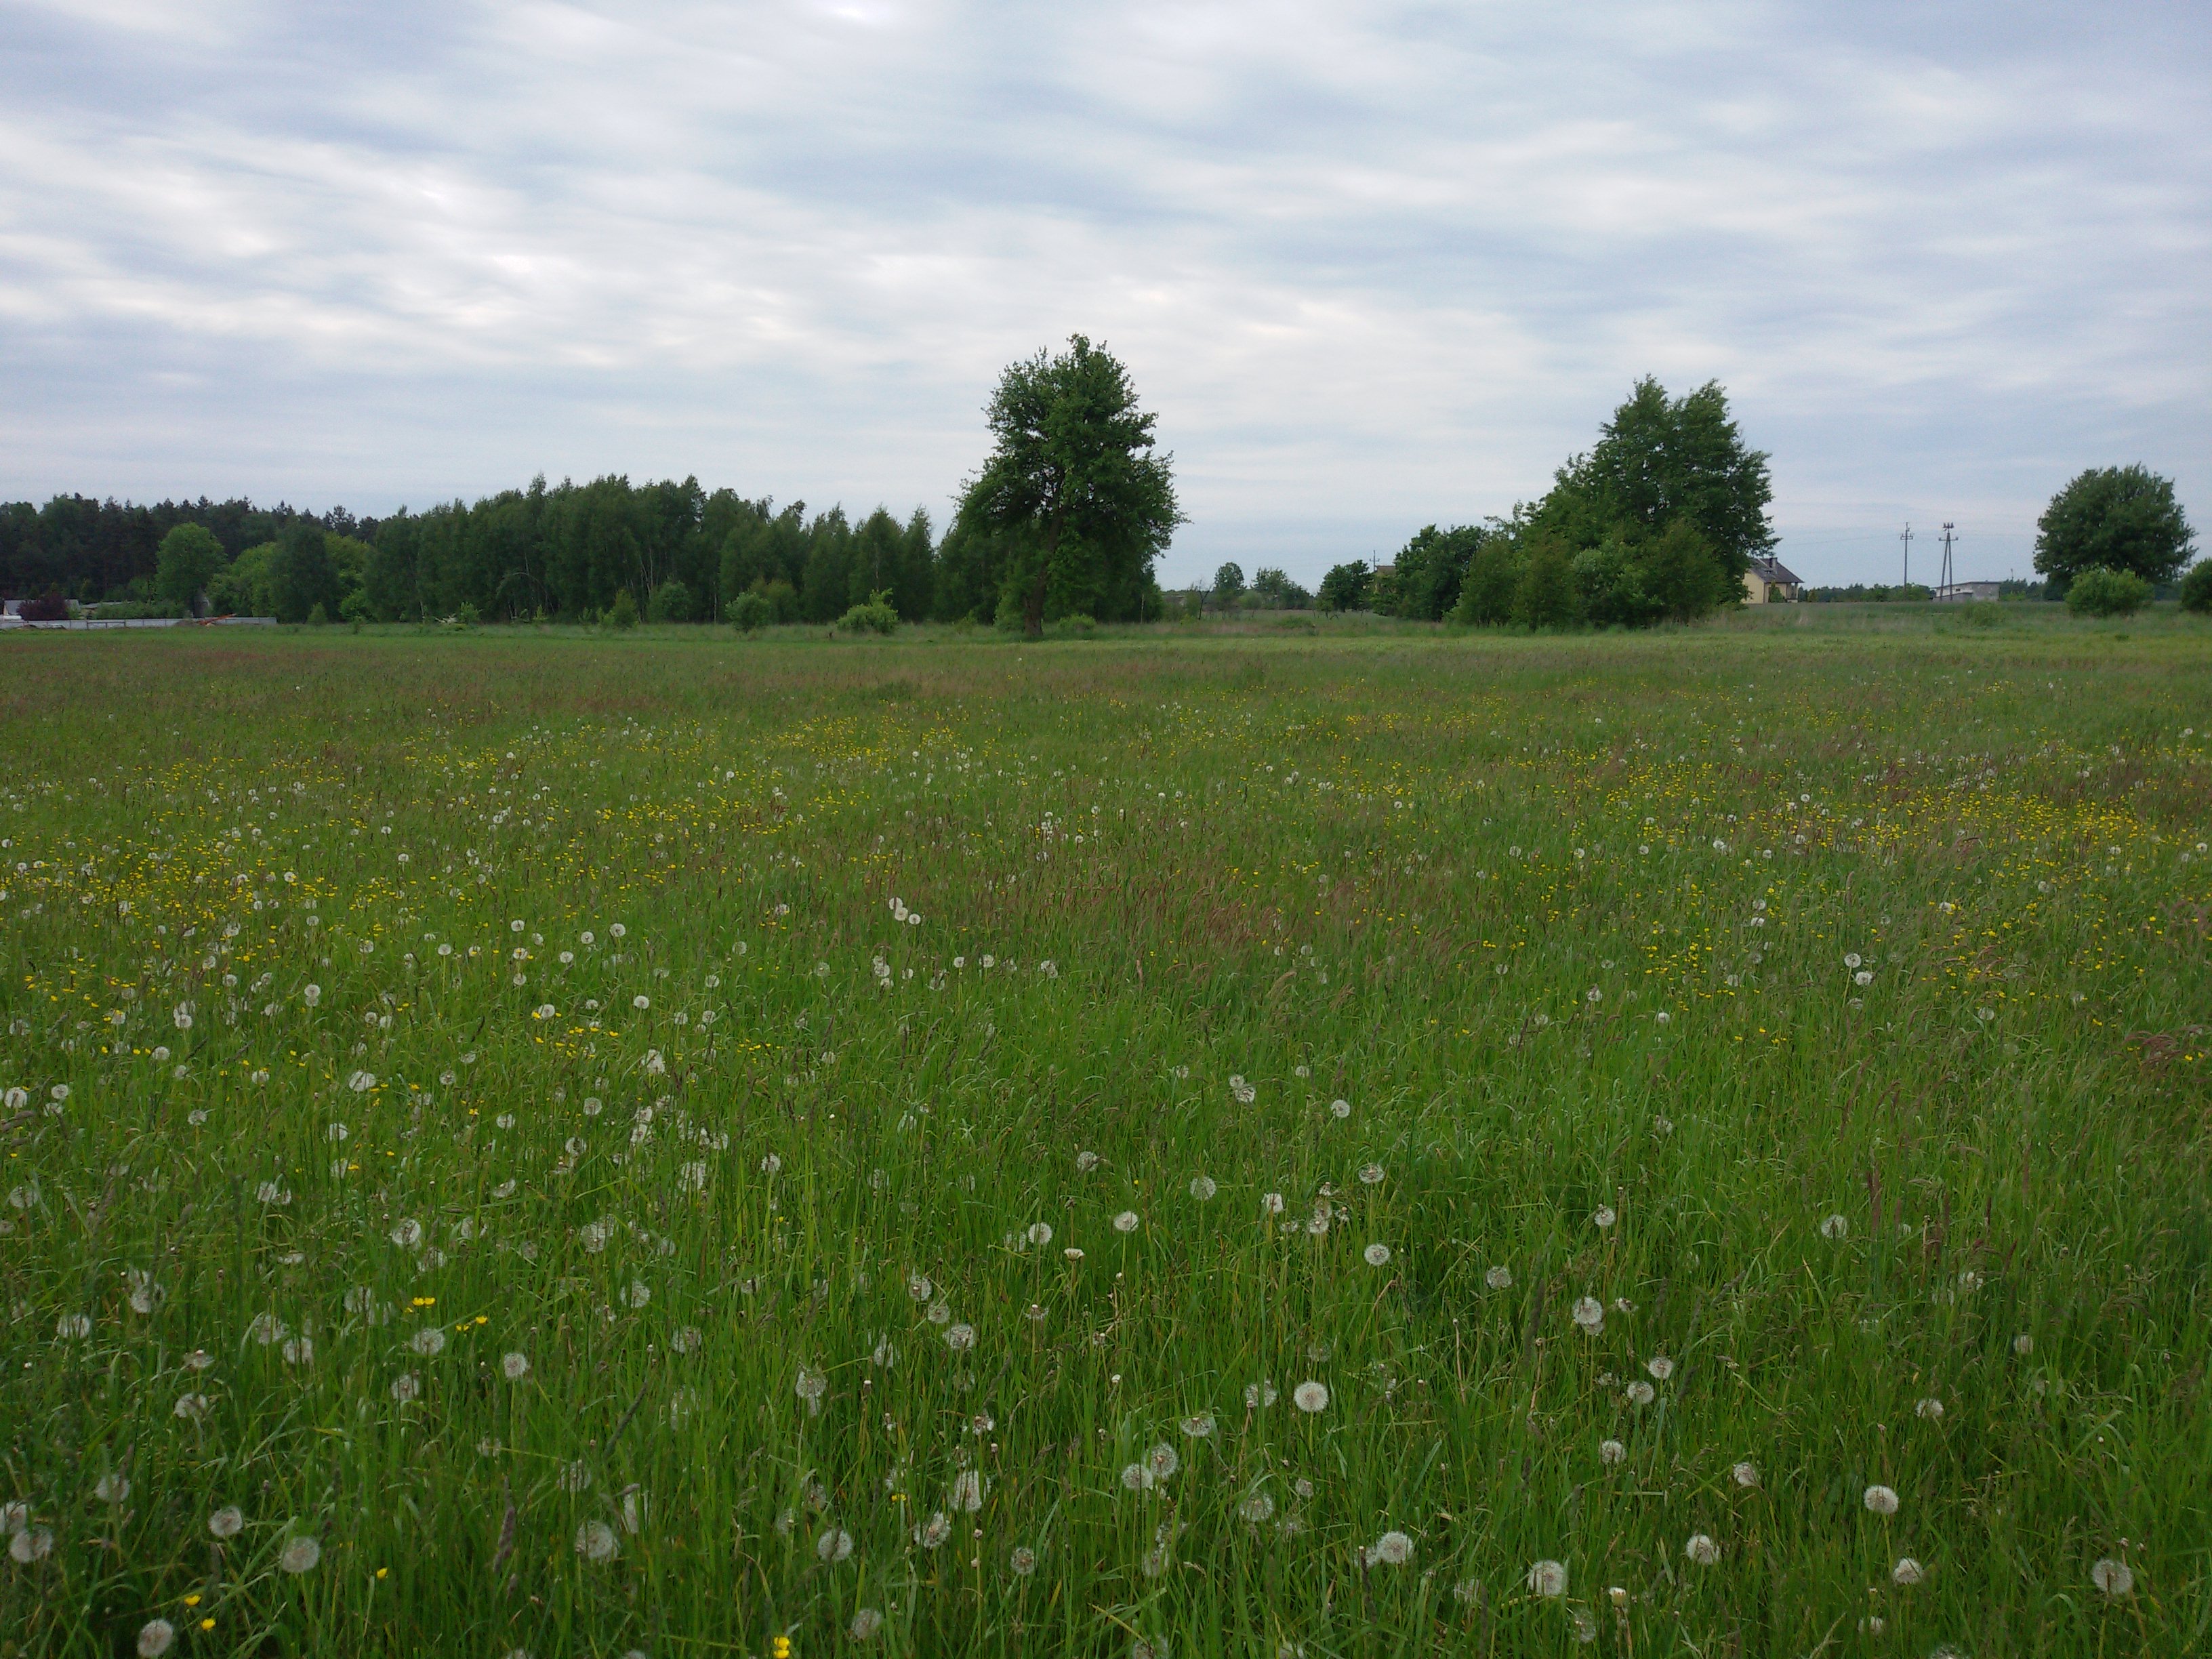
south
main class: Grassland
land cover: Grassland without tree/shrub cover
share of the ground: > 75 %
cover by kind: herbaceous plants 100 %
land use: Agriculture (excluding fallow land and kitchen gardens)
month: May
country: PL
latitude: 51.7260
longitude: 21.6791
